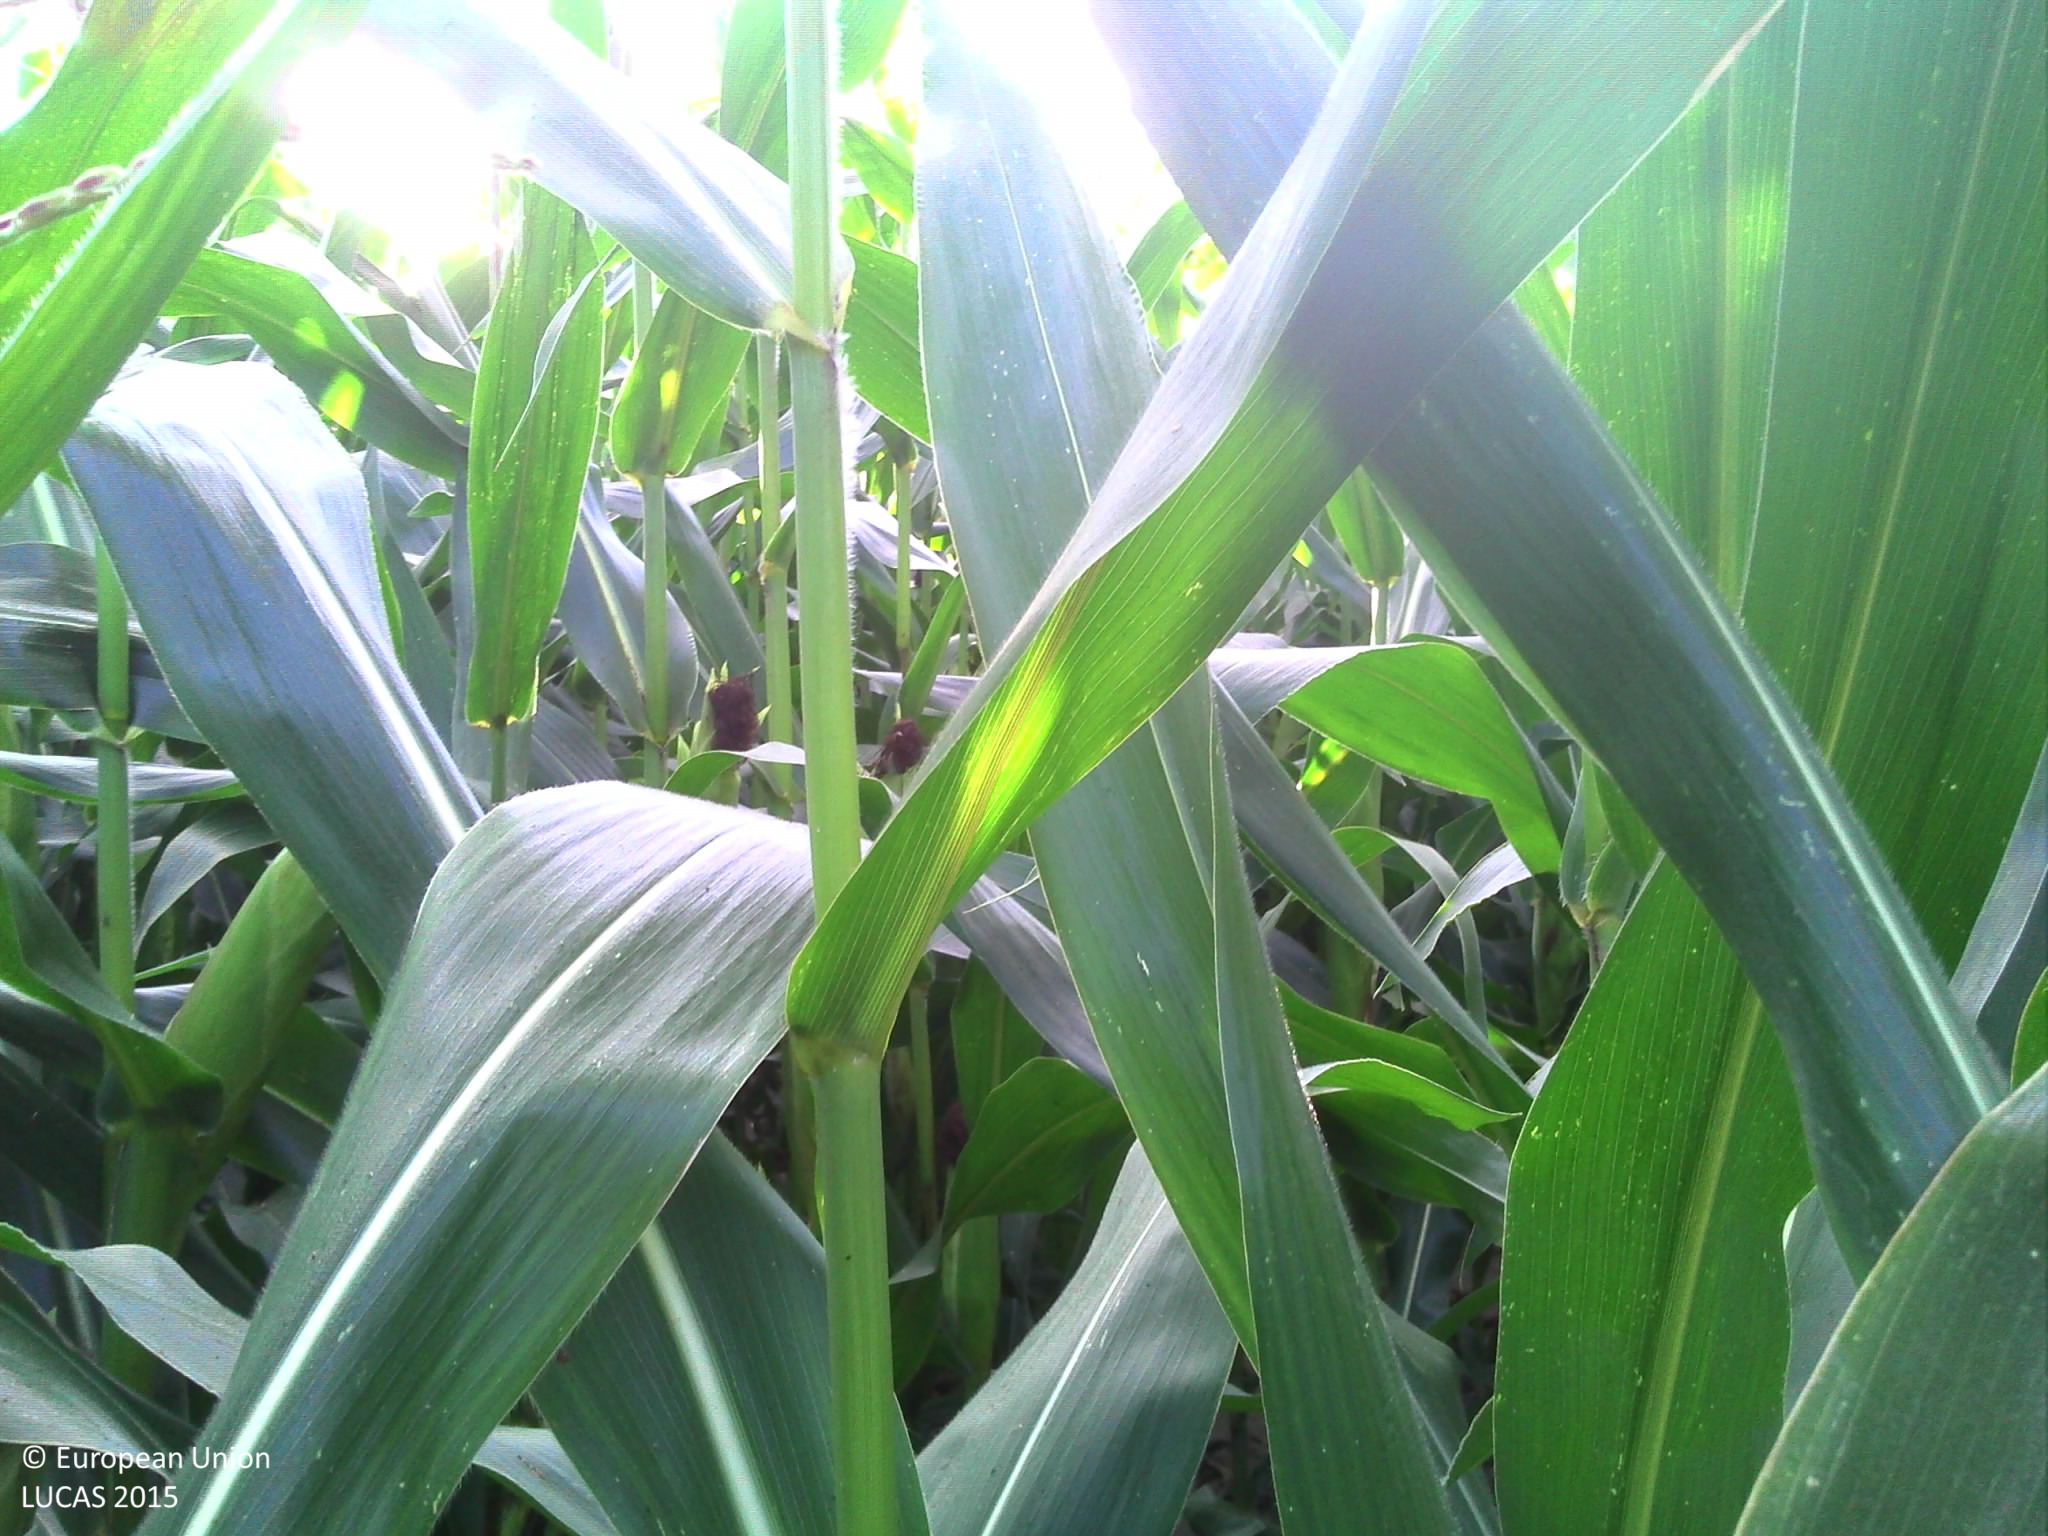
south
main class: Cropland
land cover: Maize
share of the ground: > 75 %
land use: Agriculture (excluding fallow land and kitchen gardens)
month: October
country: FR
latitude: 48.0497
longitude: -2.3868
